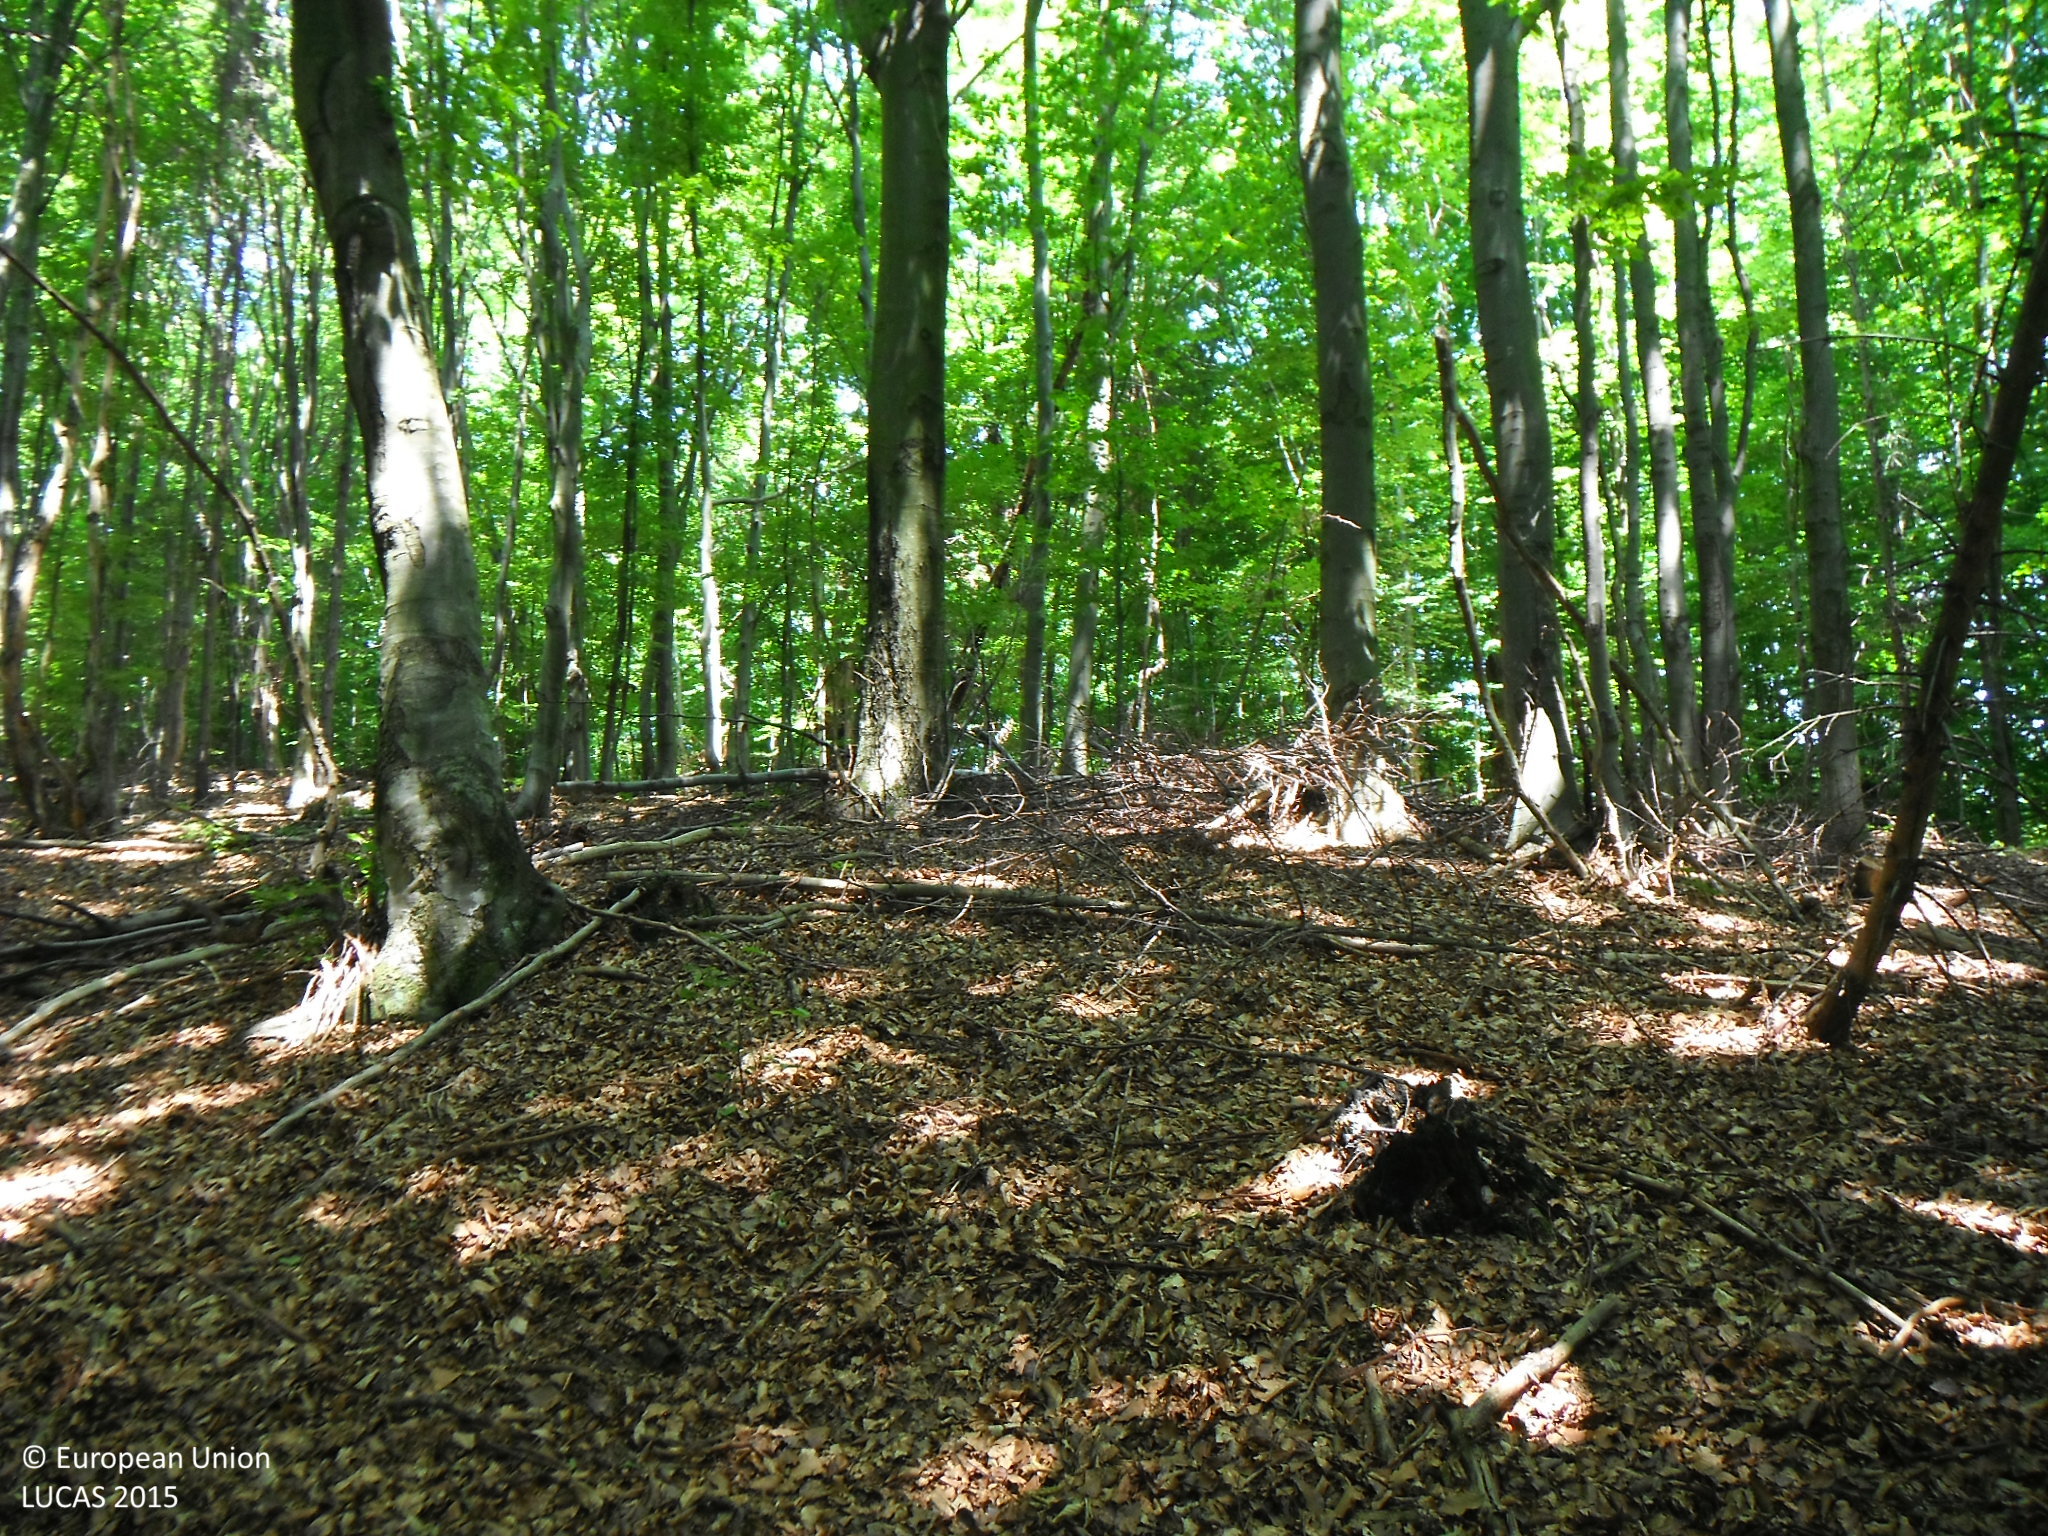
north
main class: Woodland
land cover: Broadleaved woodland
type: beech forest
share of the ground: > 75 %
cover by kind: broadleaved forest trees 100 %
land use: Forestry
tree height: > 5 m
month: July
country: SK
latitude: 49.3775
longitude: 21.1878
